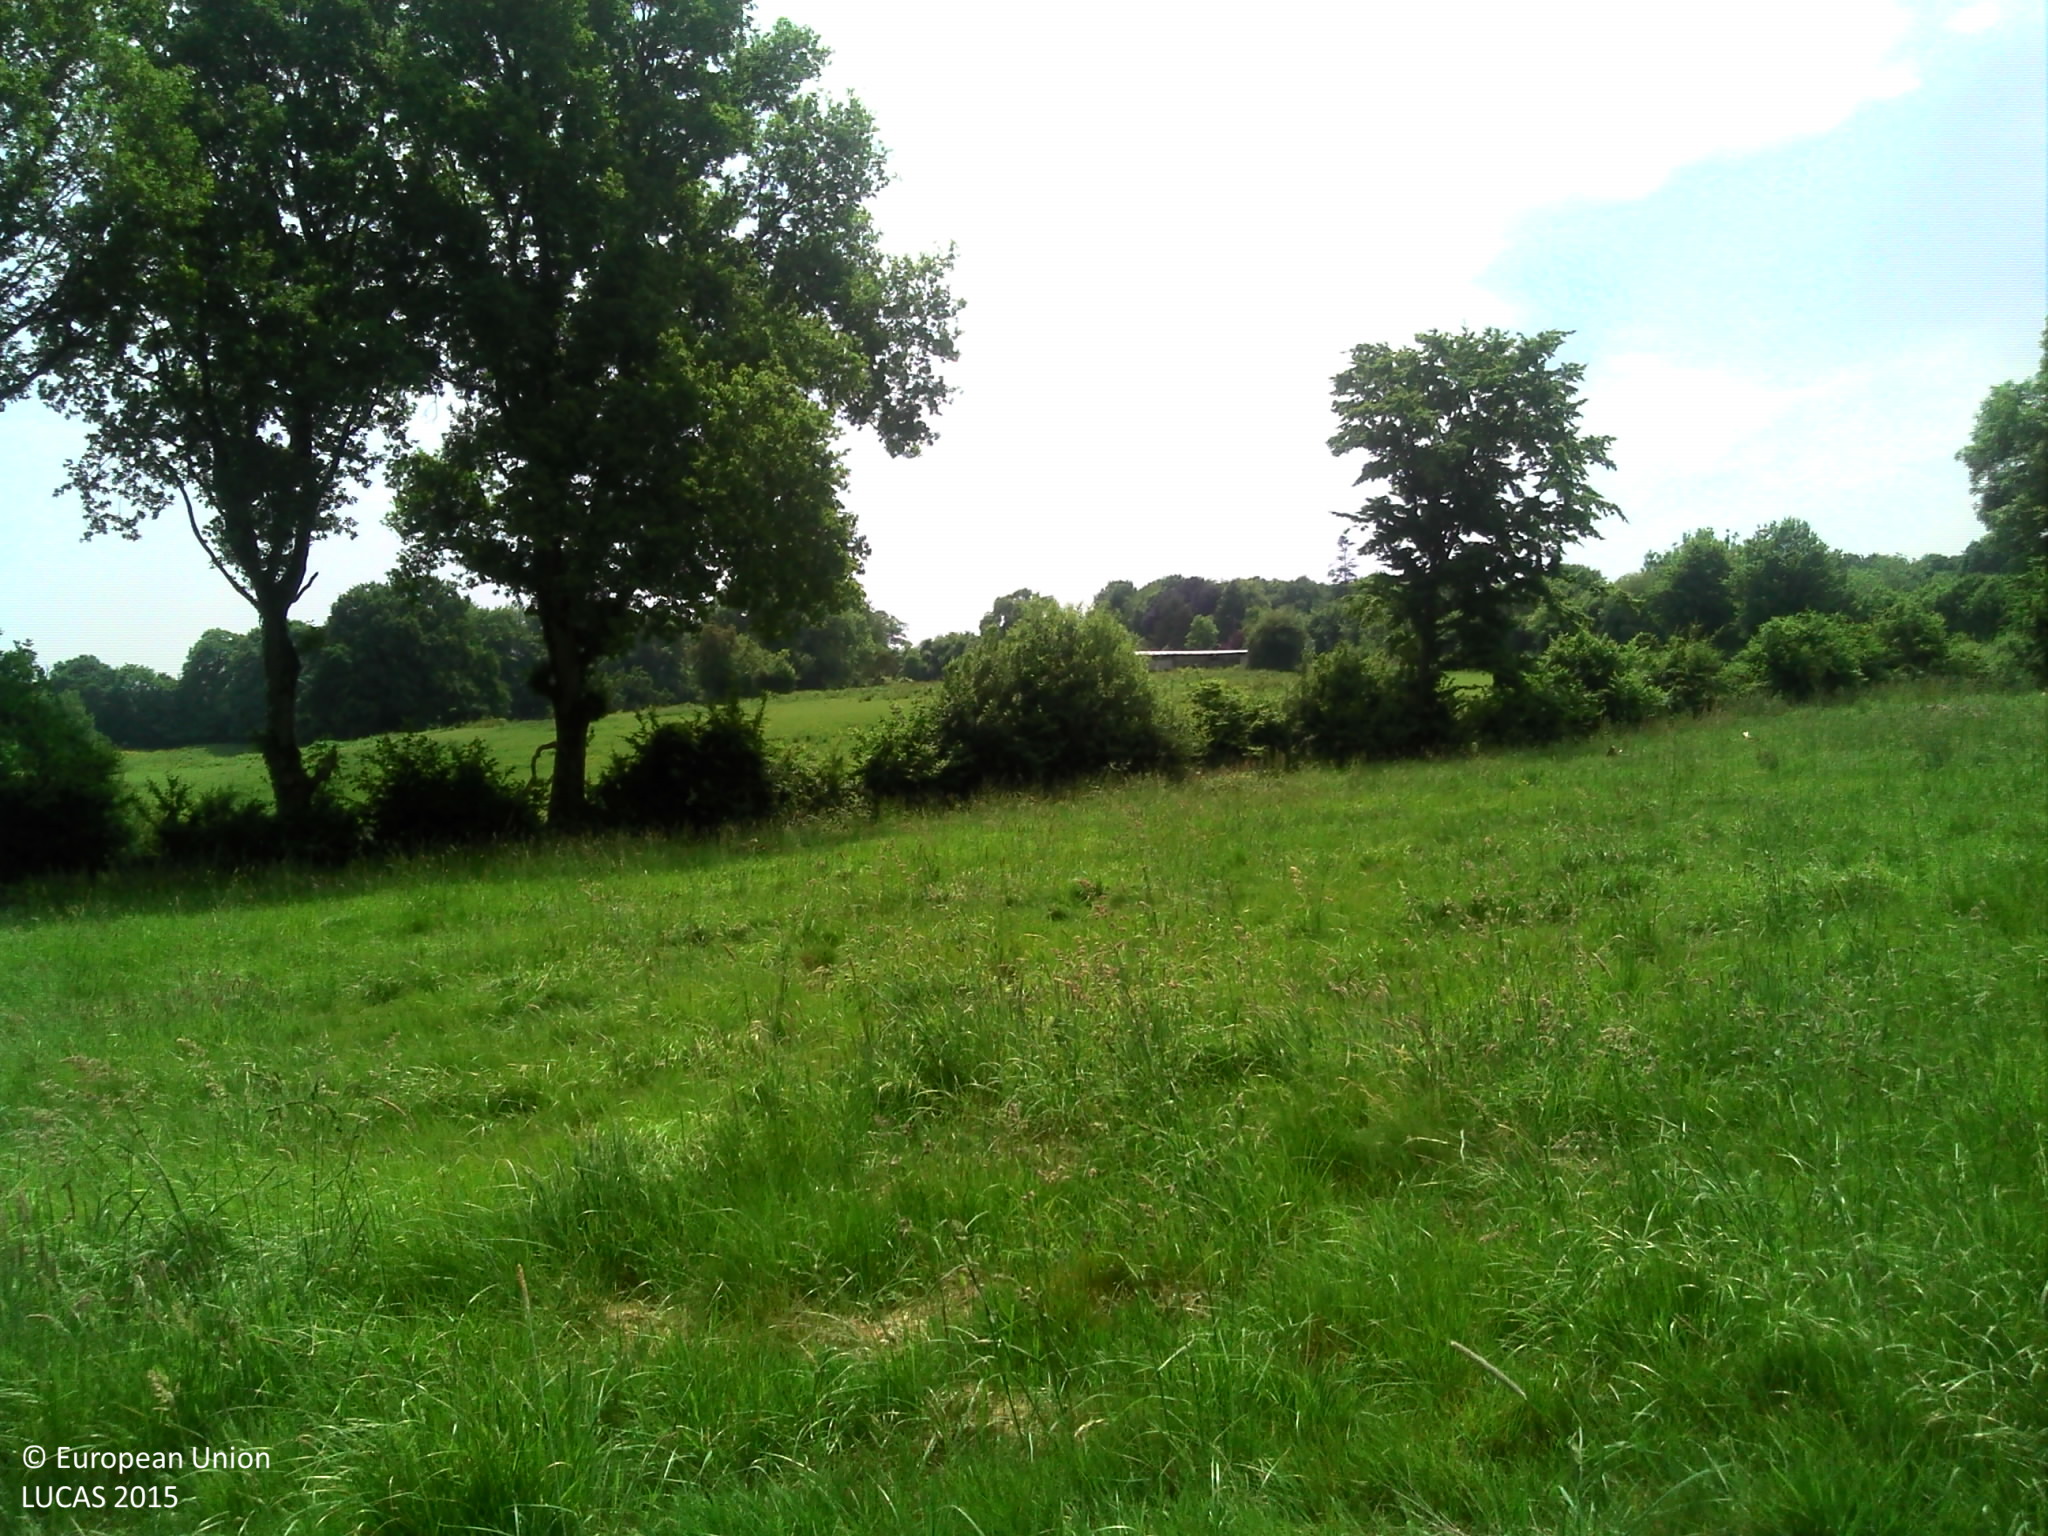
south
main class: Grassland
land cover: Grassland without tree/shrub cover
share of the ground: > 75 %
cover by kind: herbaceous plants 95 %
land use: Agriculture (excluding fallow land and kitchen gardens)
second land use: Forestry
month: June
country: FR
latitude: 48.6900
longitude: 0.1772
